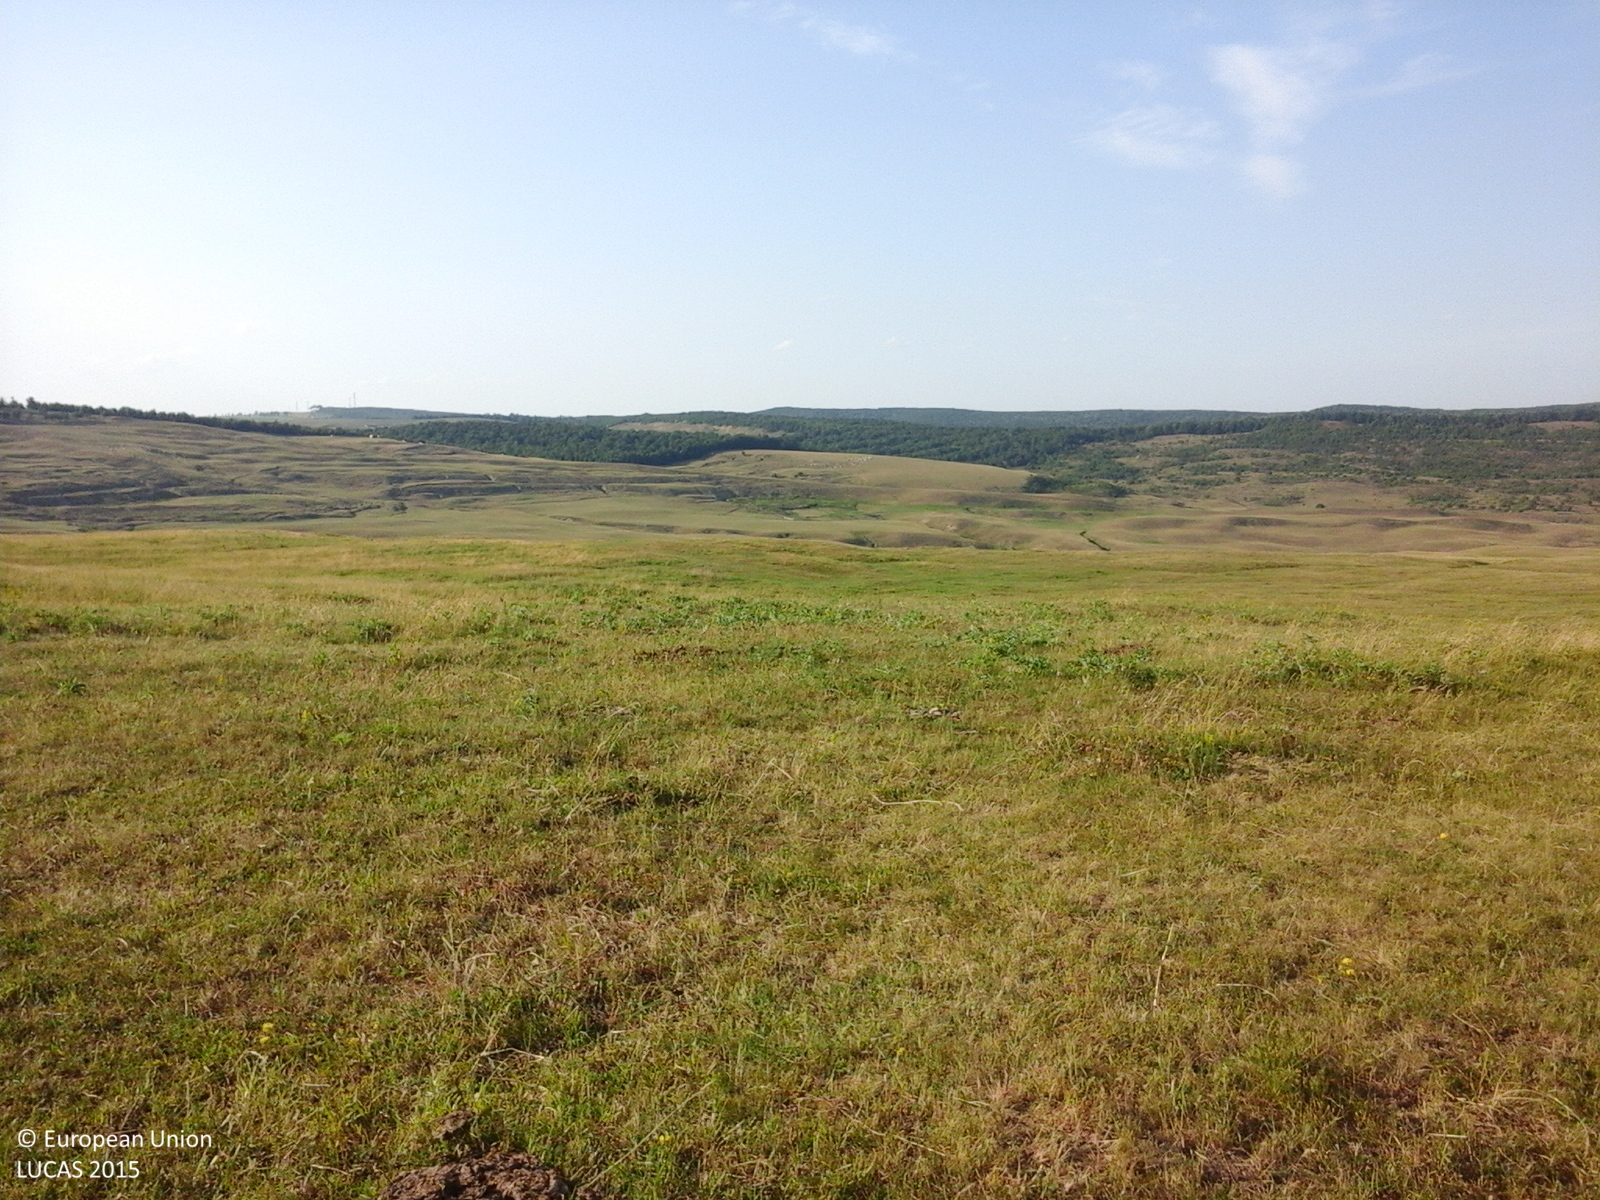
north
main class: Grassland
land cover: Grassland without tree/shrub cover
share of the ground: > 75 %
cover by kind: herbaceous plants 100 %
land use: Agriculture (excluding fallow land and kitchen gardens)
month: June
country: RO
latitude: 47.6746
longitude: 26.5679
